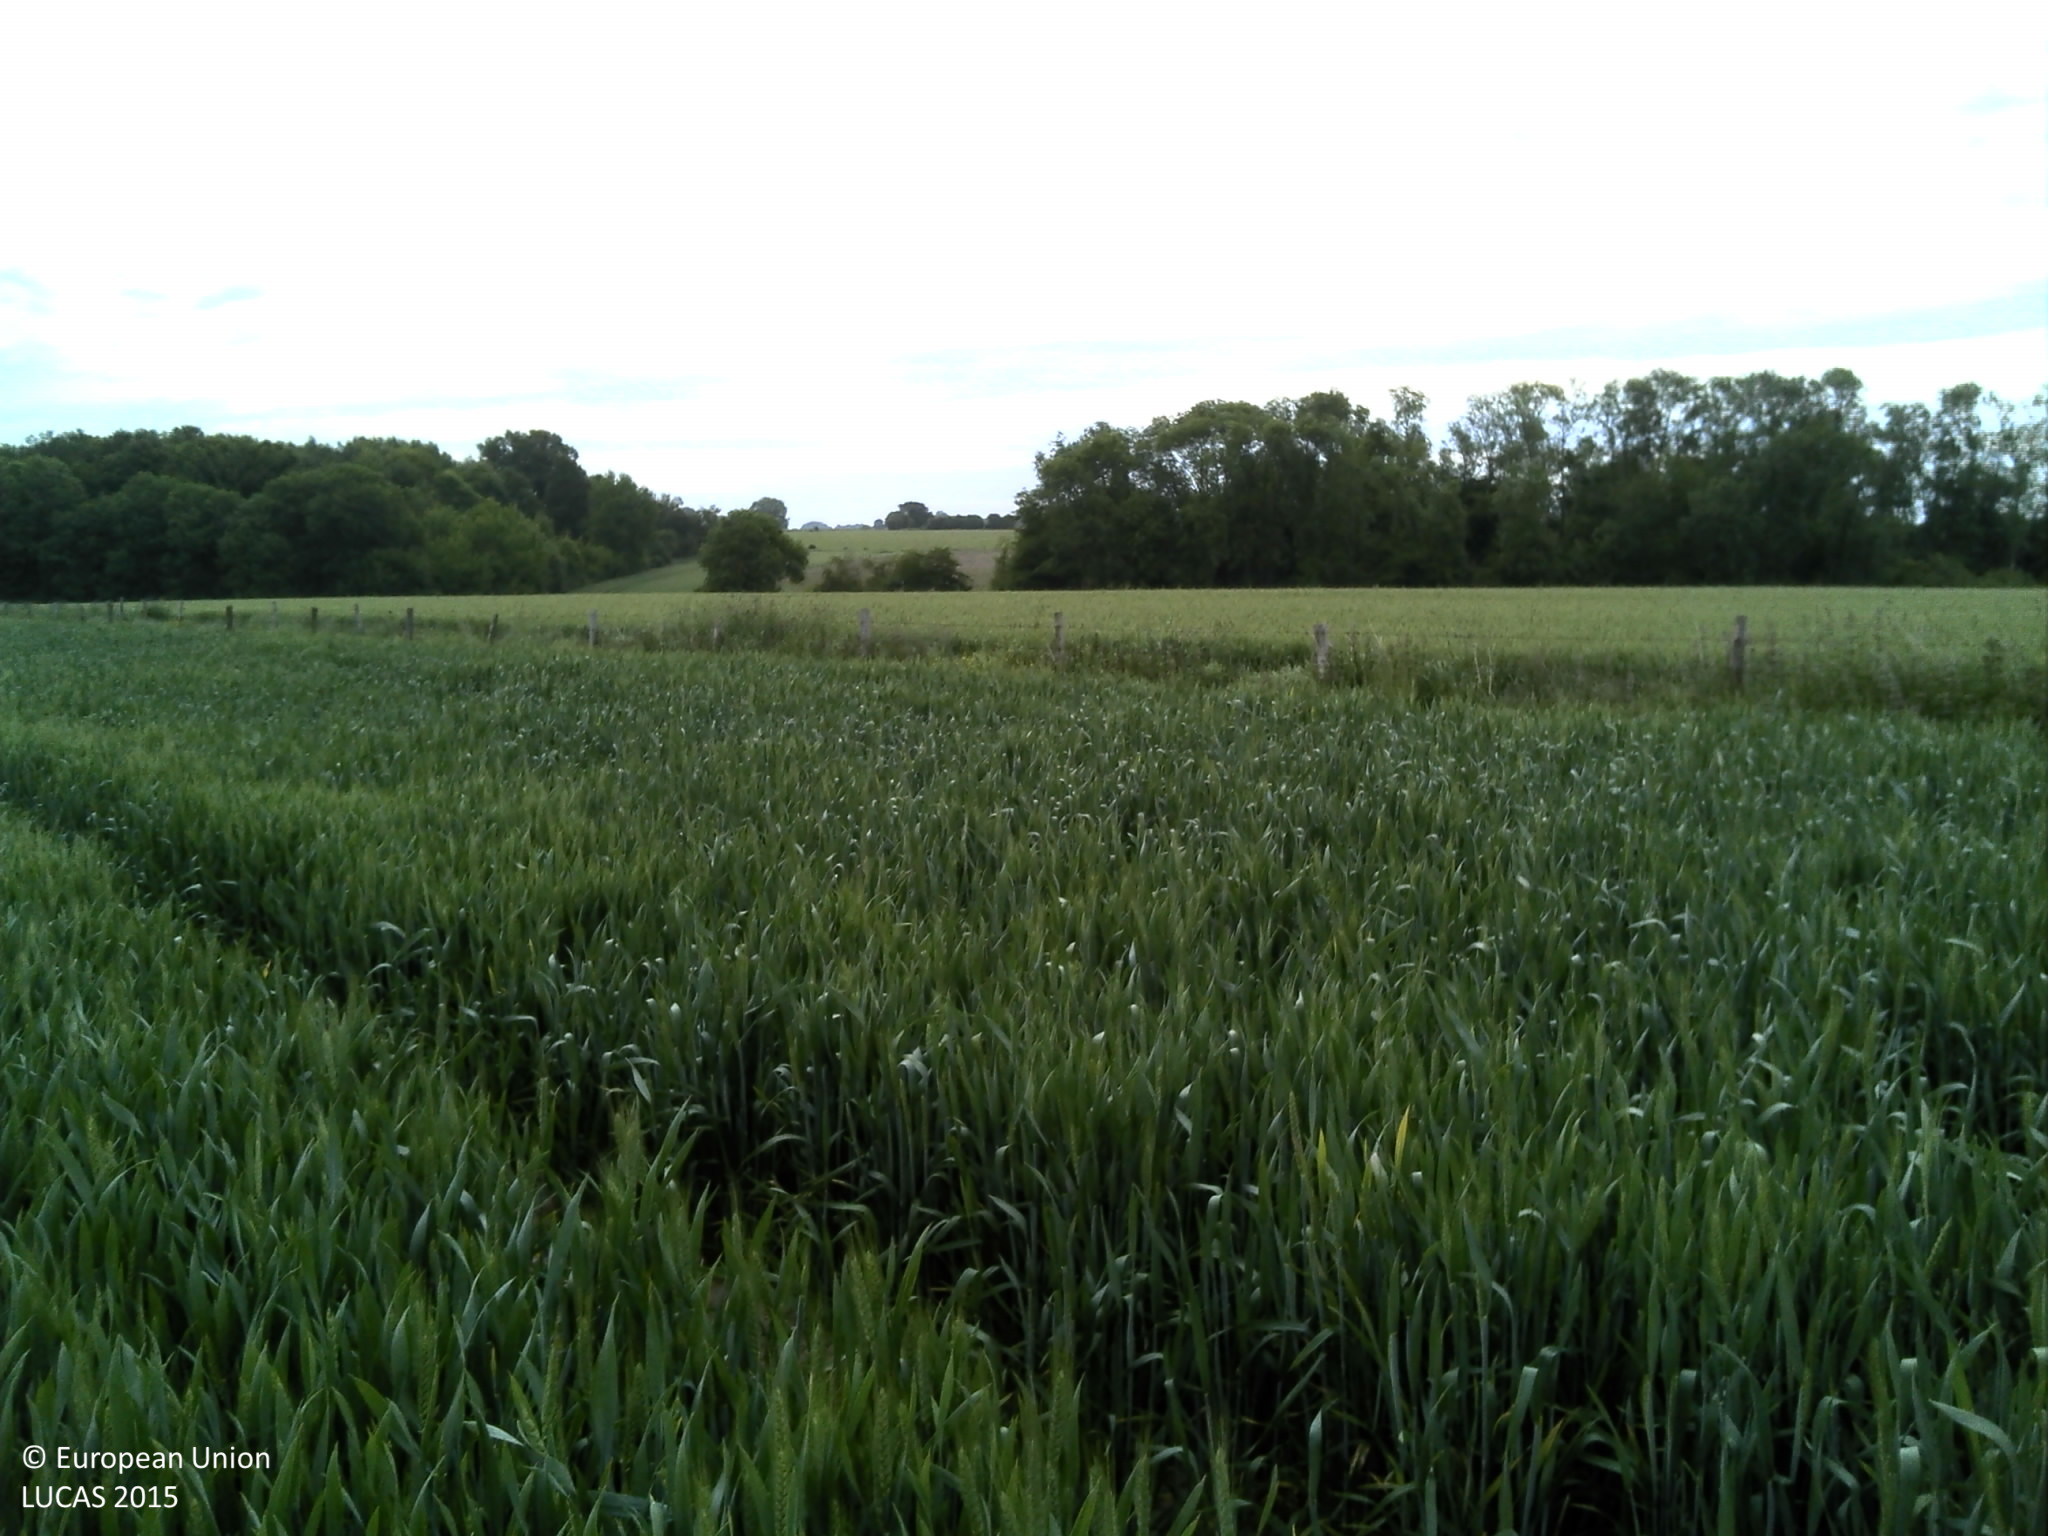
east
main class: Cropland
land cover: Durum wheat
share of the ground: > 75 %
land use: Agriculture (excluding fallow land and kitchen gardens)
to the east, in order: Durum wheat; Fences; Durum wheat; Broadleaved woodland; Fences; Grassland without tree/shrub cover
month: May
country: FR
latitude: 49.3936
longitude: 1.2306
